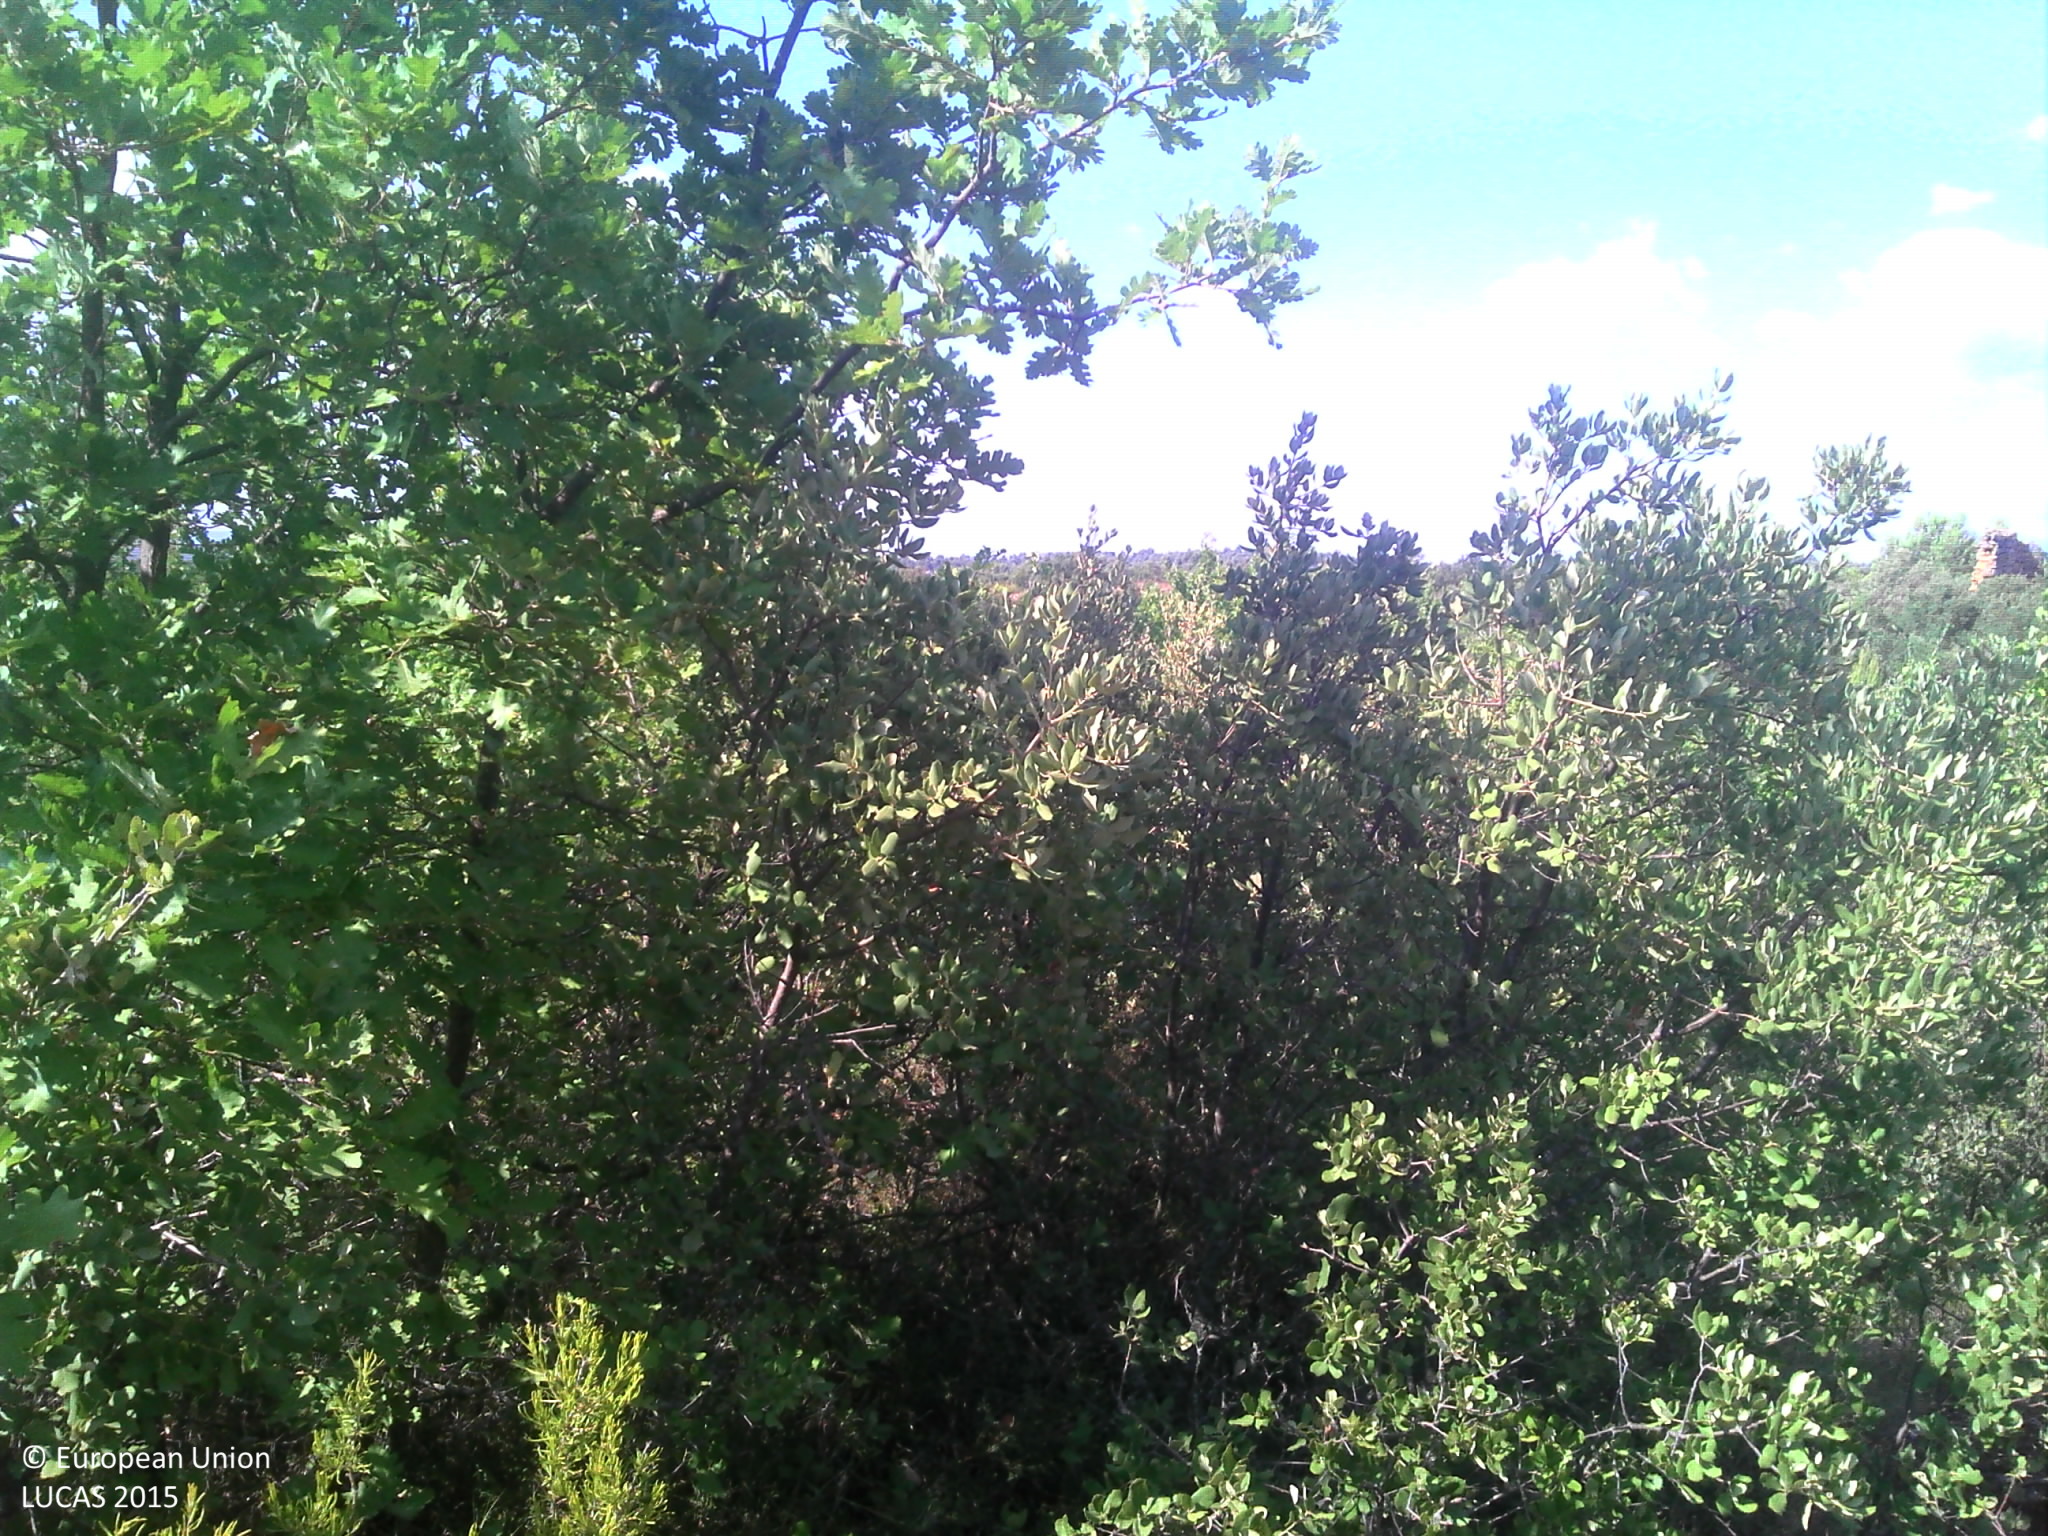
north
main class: Shrubland
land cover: Shrubland with sparse tree cover
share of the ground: > 75 %
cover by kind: shrubs 50 %, herbaceous plants 30 %, unconsolidated bare surface 10 %, broadleaved forest trees 5 %, lichens and mosses 5 %
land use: Forestry
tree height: < 5 m
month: August
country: FR
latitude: 43.6264
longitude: 5.6344
